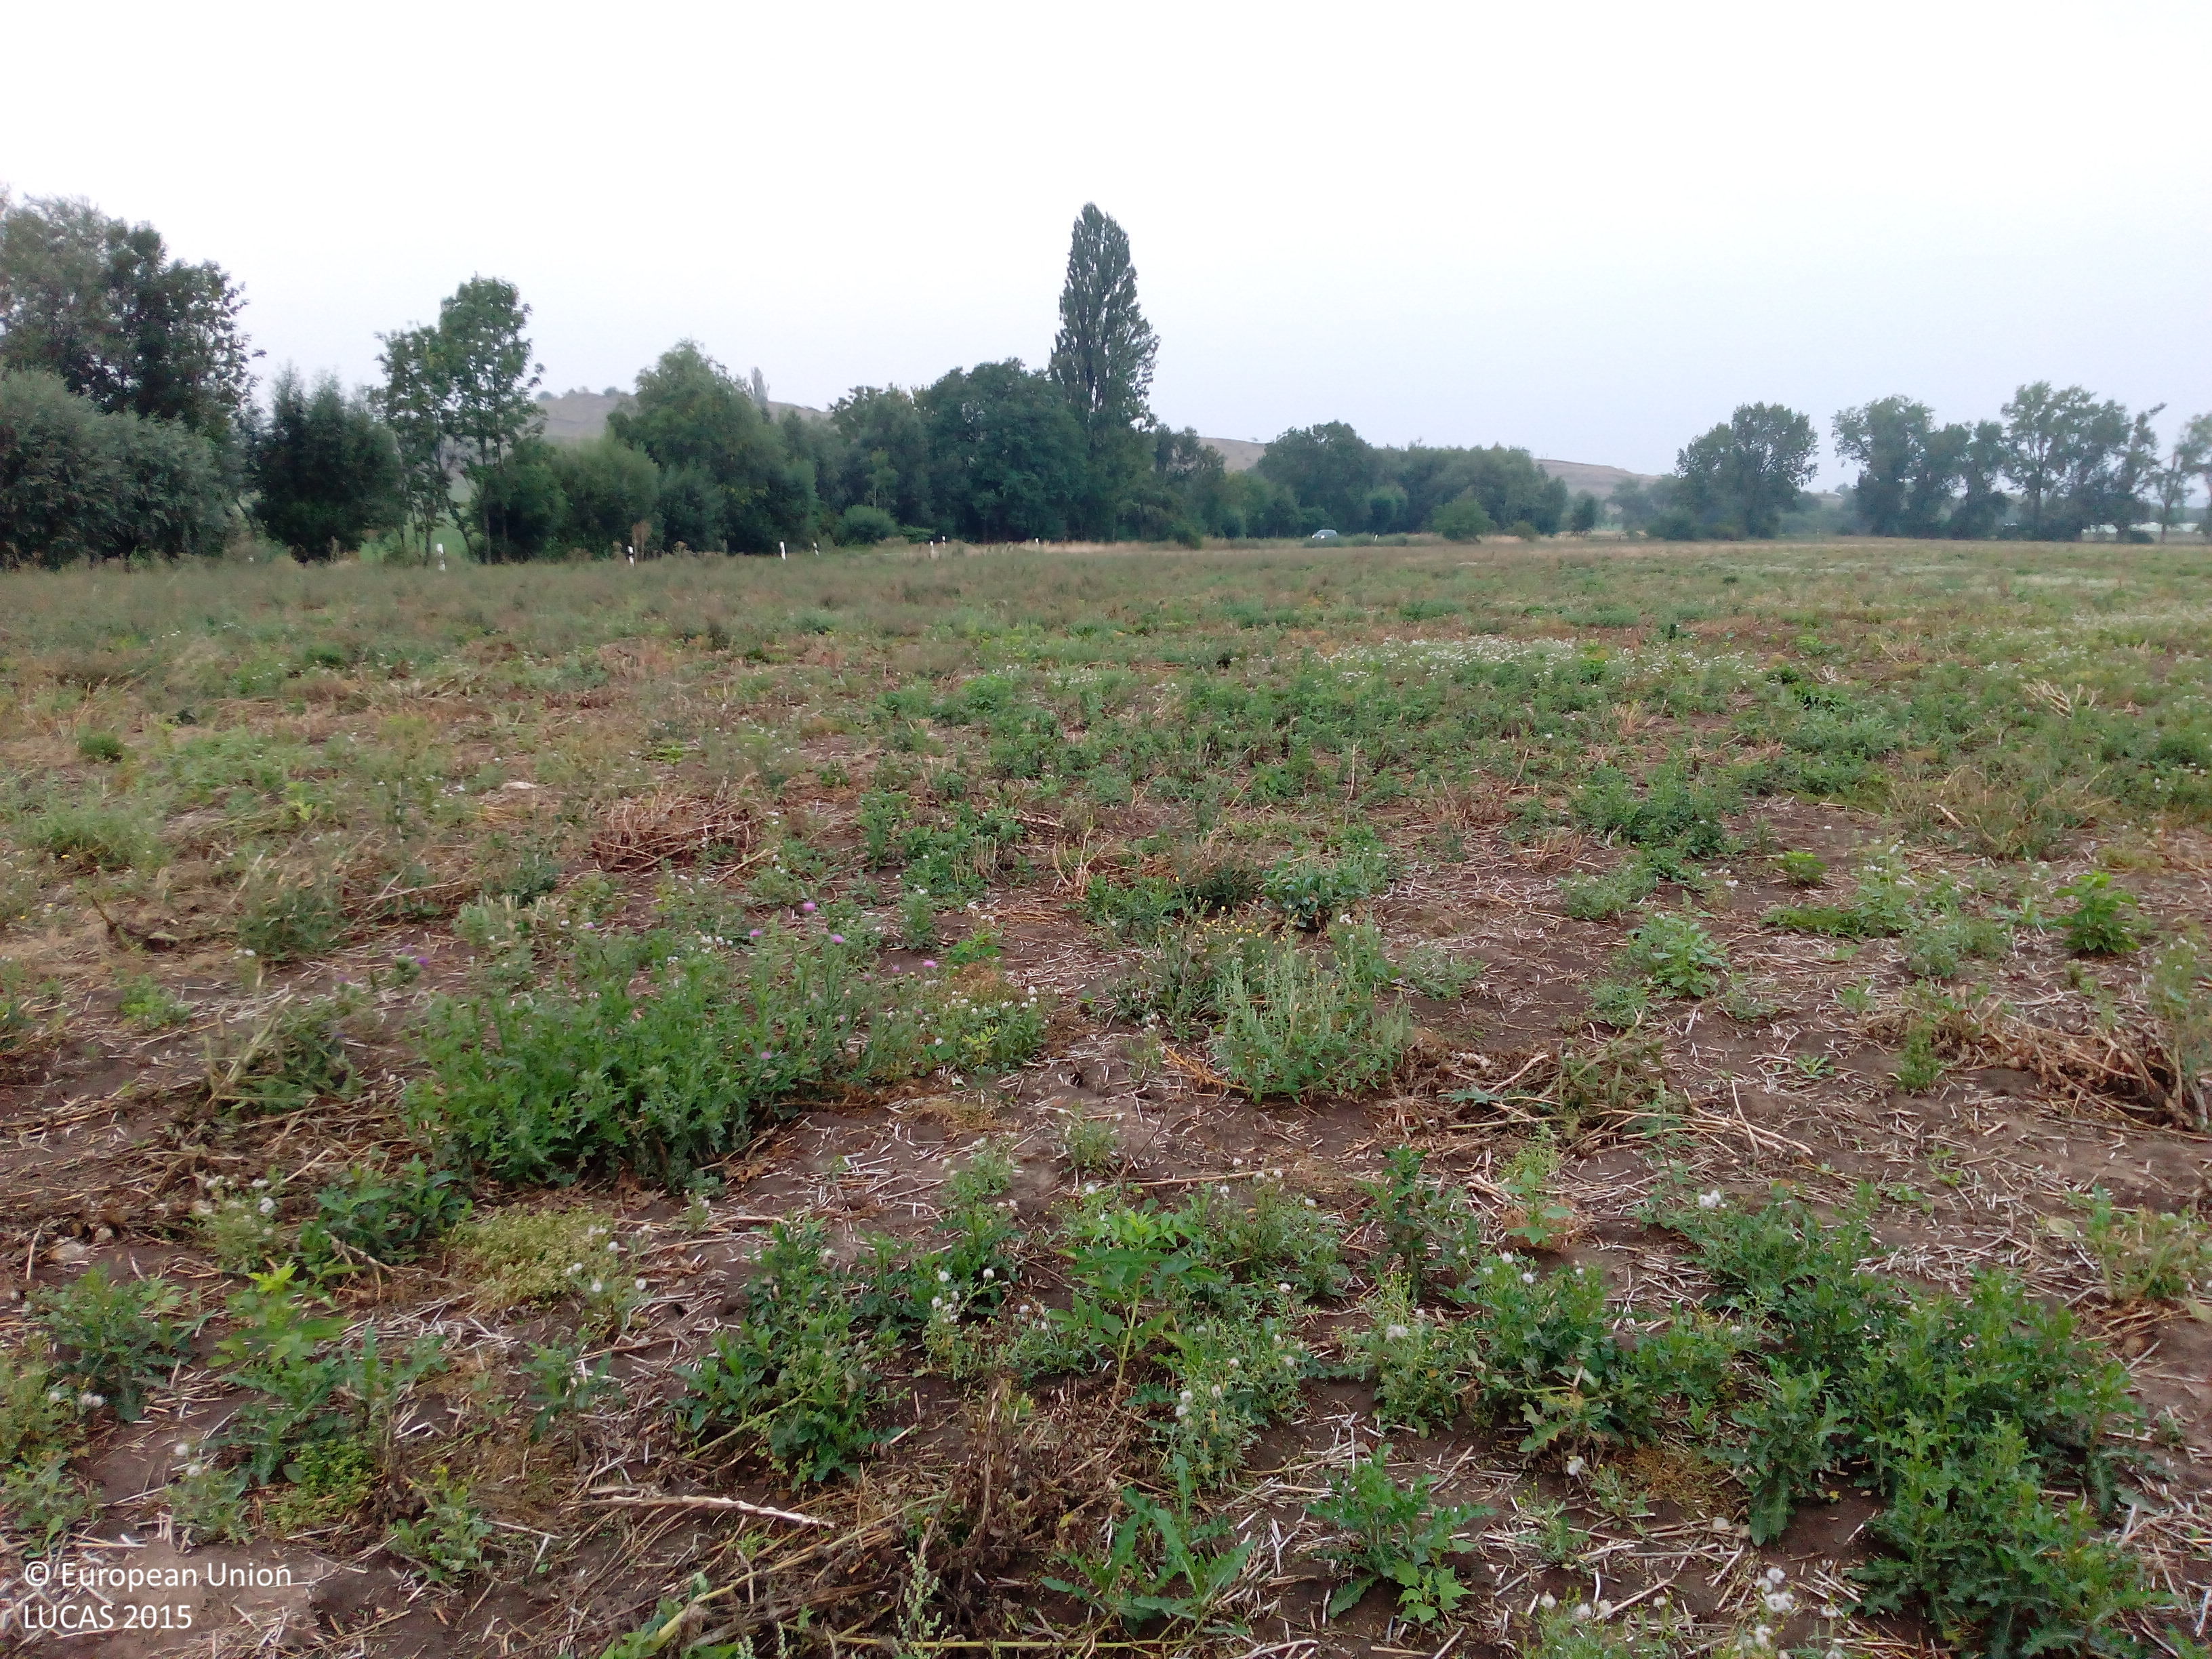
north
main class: Grassland
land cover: Spontaneously vegetated surfaces
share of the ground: 25 - 50 %
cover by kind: unconsolidated bare surface 60 %, herbaceous plants 40 %
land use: Fallow land
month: August
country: DE
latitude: 51.0254
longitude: 10.9550
